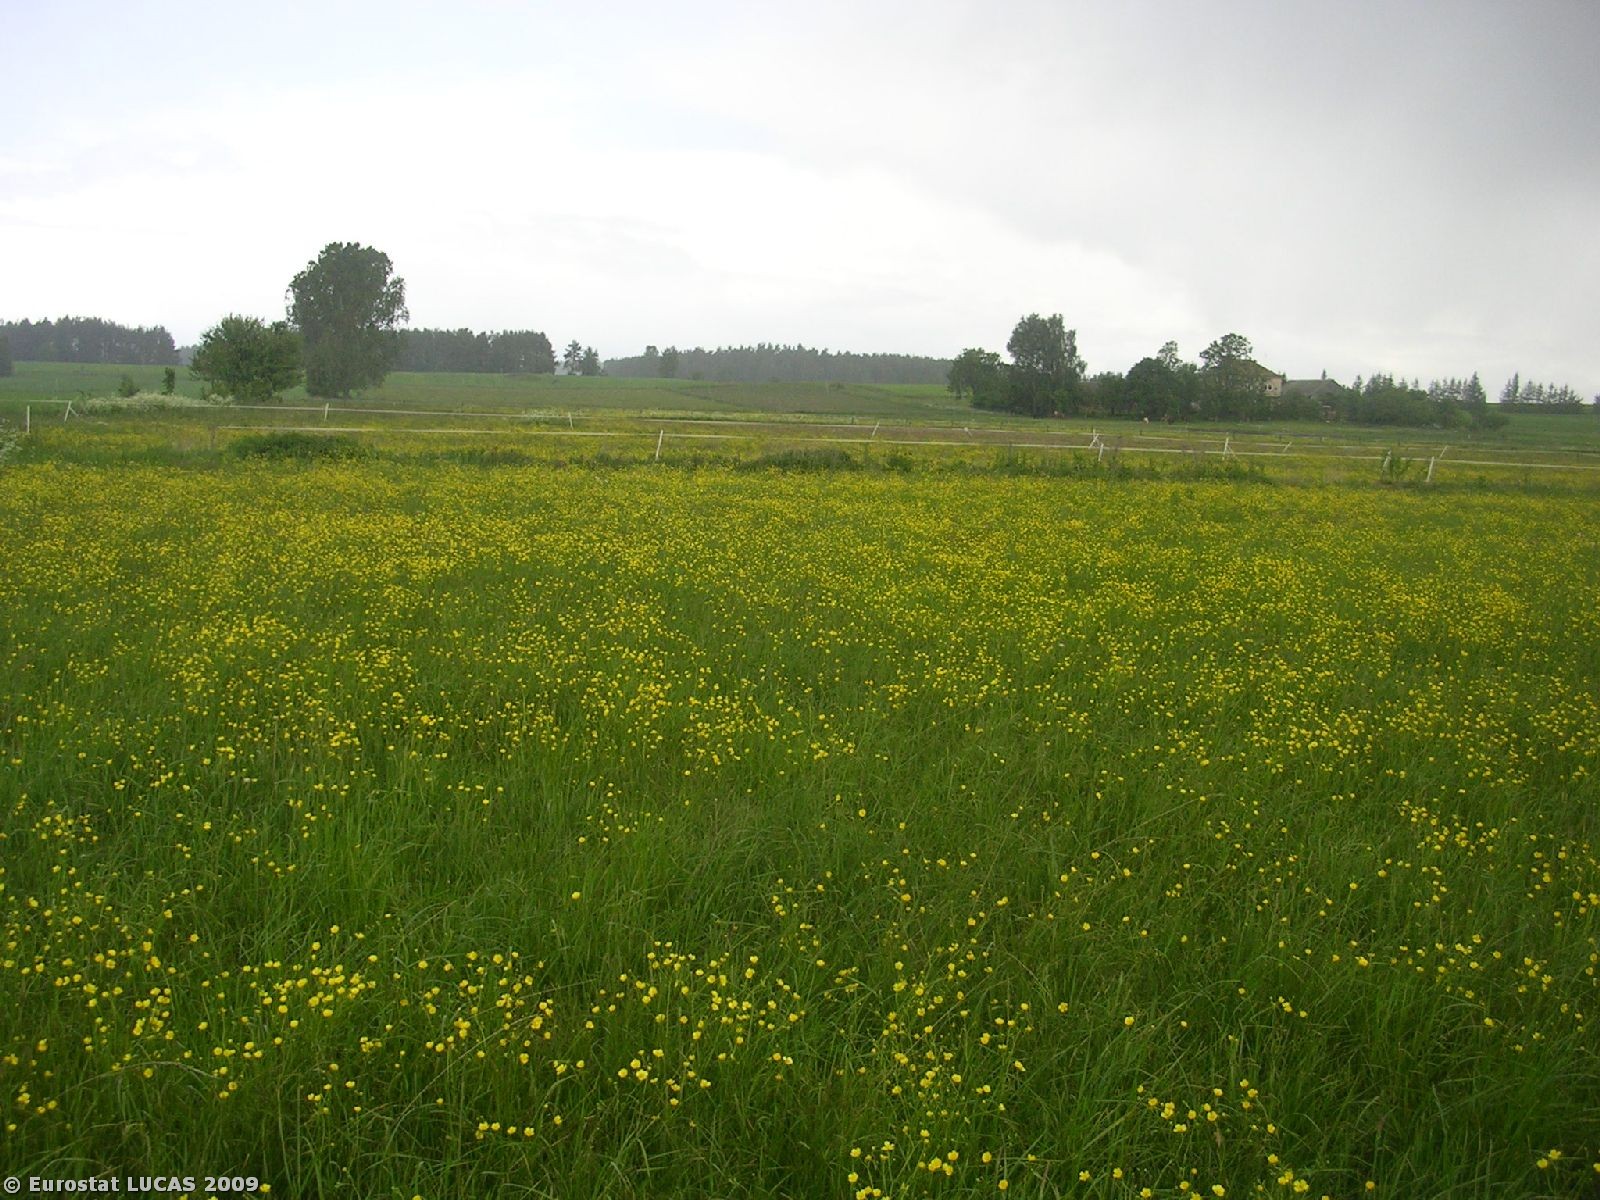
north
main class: Grassland
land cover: Grassland without tree/shrub cover
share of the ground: > 75 %
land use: Agriculture (excluding fallow land and kitchen gardens)
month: April
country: PL
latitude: 53.4157
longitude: 23.4277
